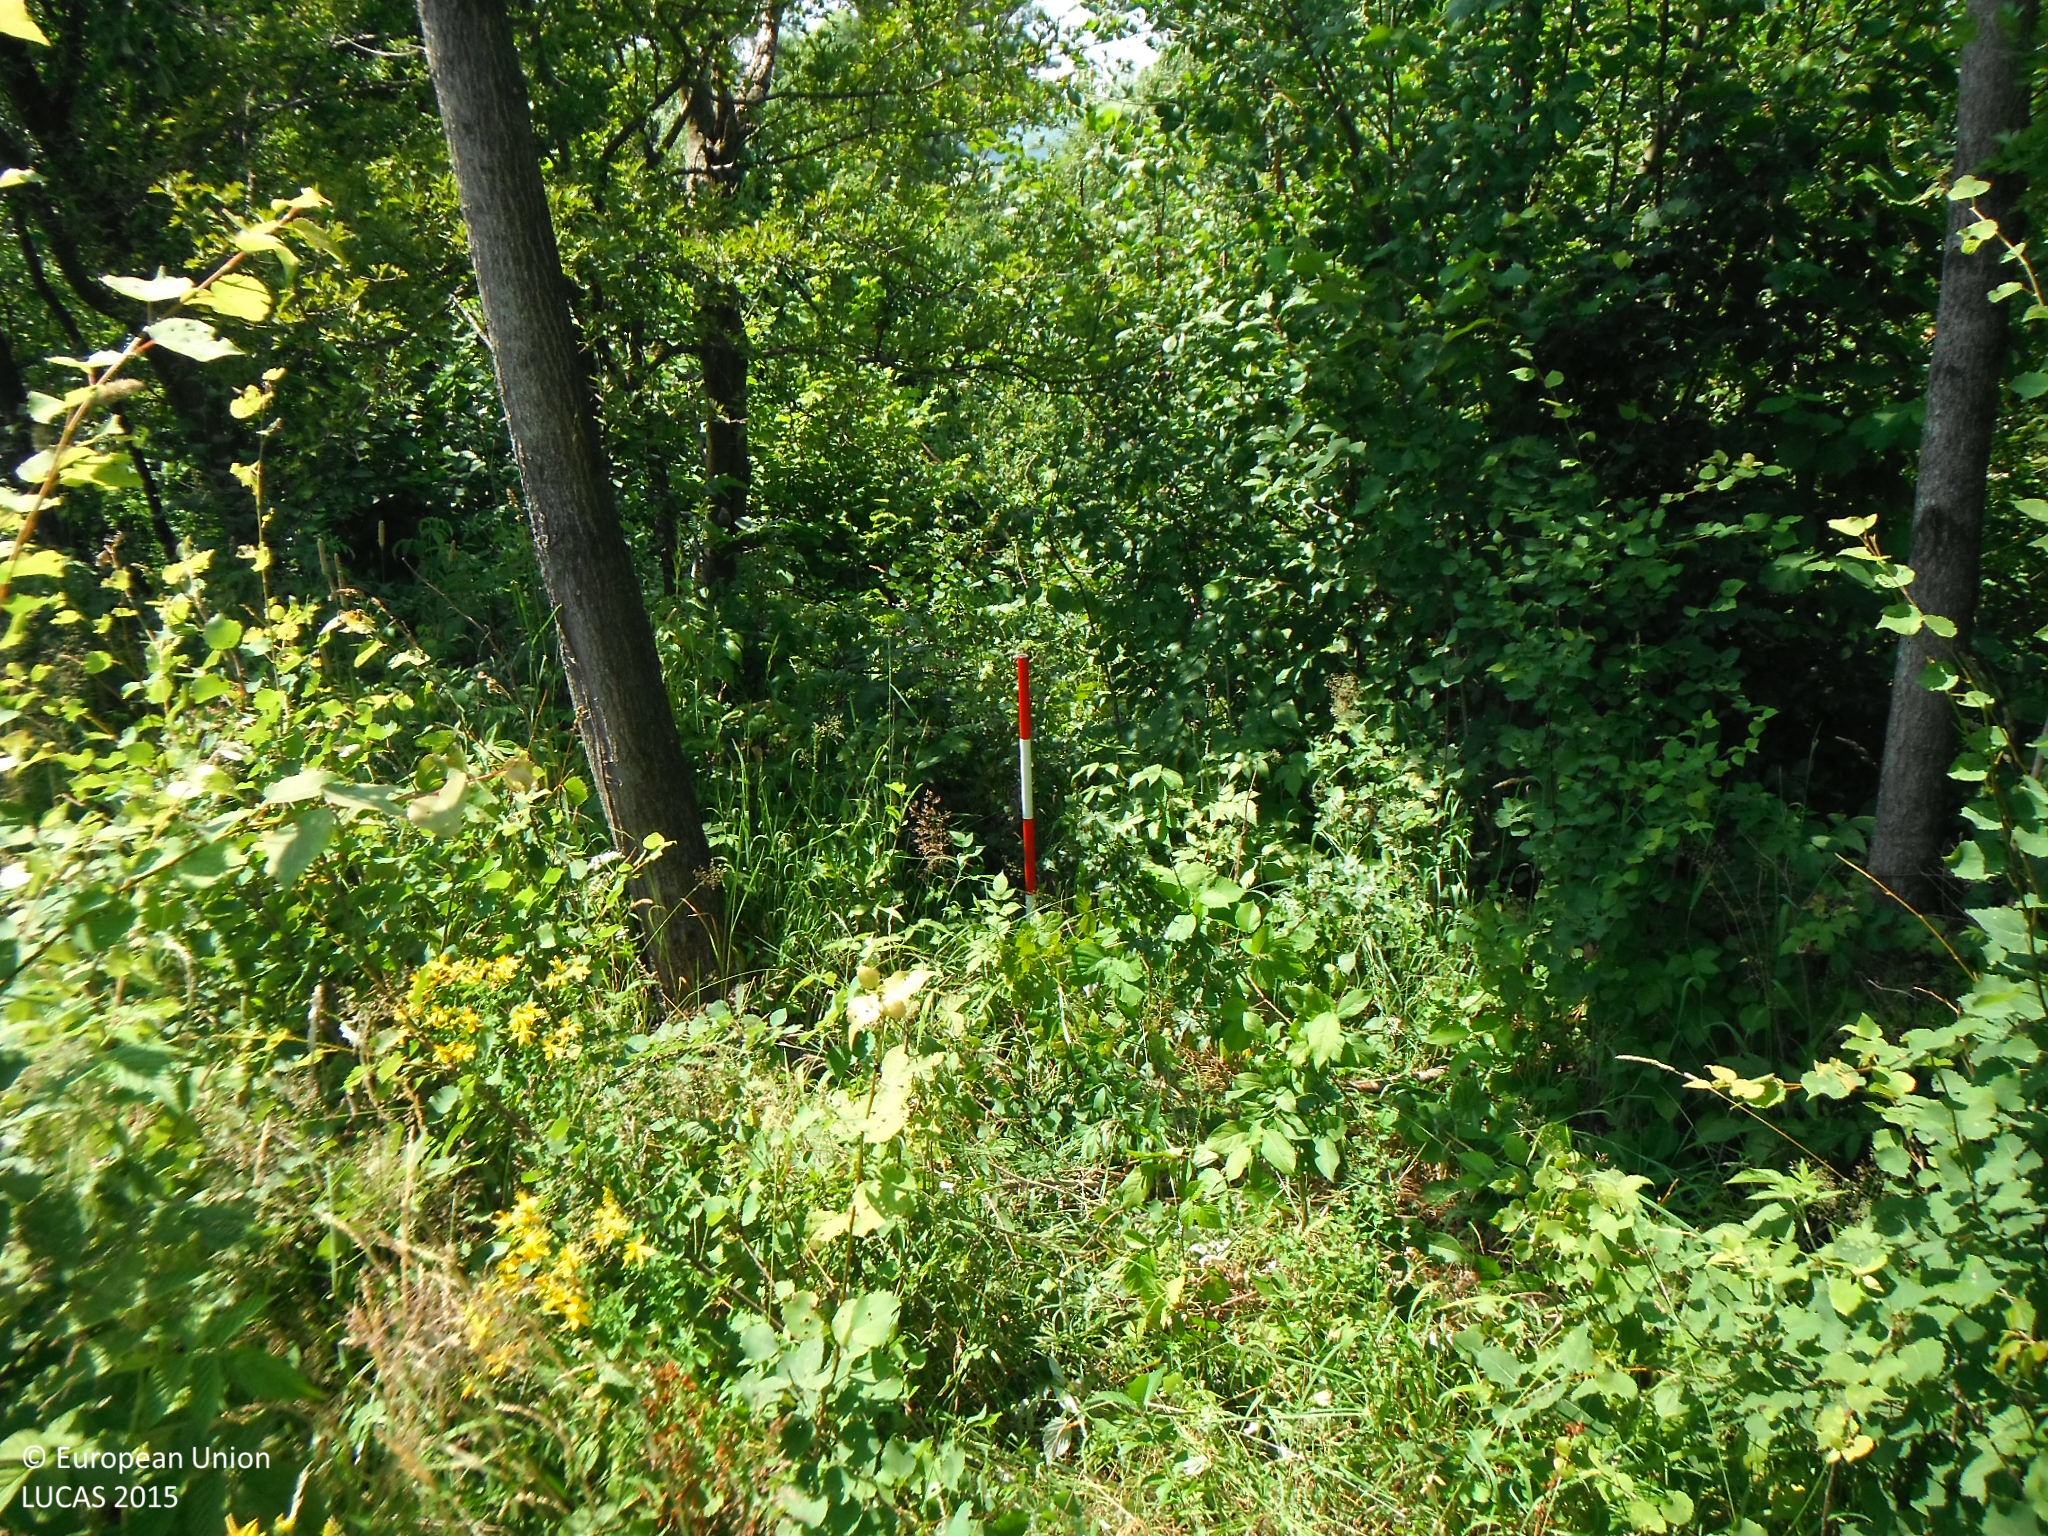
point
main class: Woodland
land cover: Broadleaved woodland
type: mesophytic deciduous forest
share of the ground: 25 - 50 %
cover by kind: broadleaved forest trees 50 %, shrubs 30 %, herbaceous plants 20 %
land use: Semi-natural and natural areas not in use
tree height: > 5 m
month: July
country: SK
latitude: 49.3624
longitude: 21.1565
